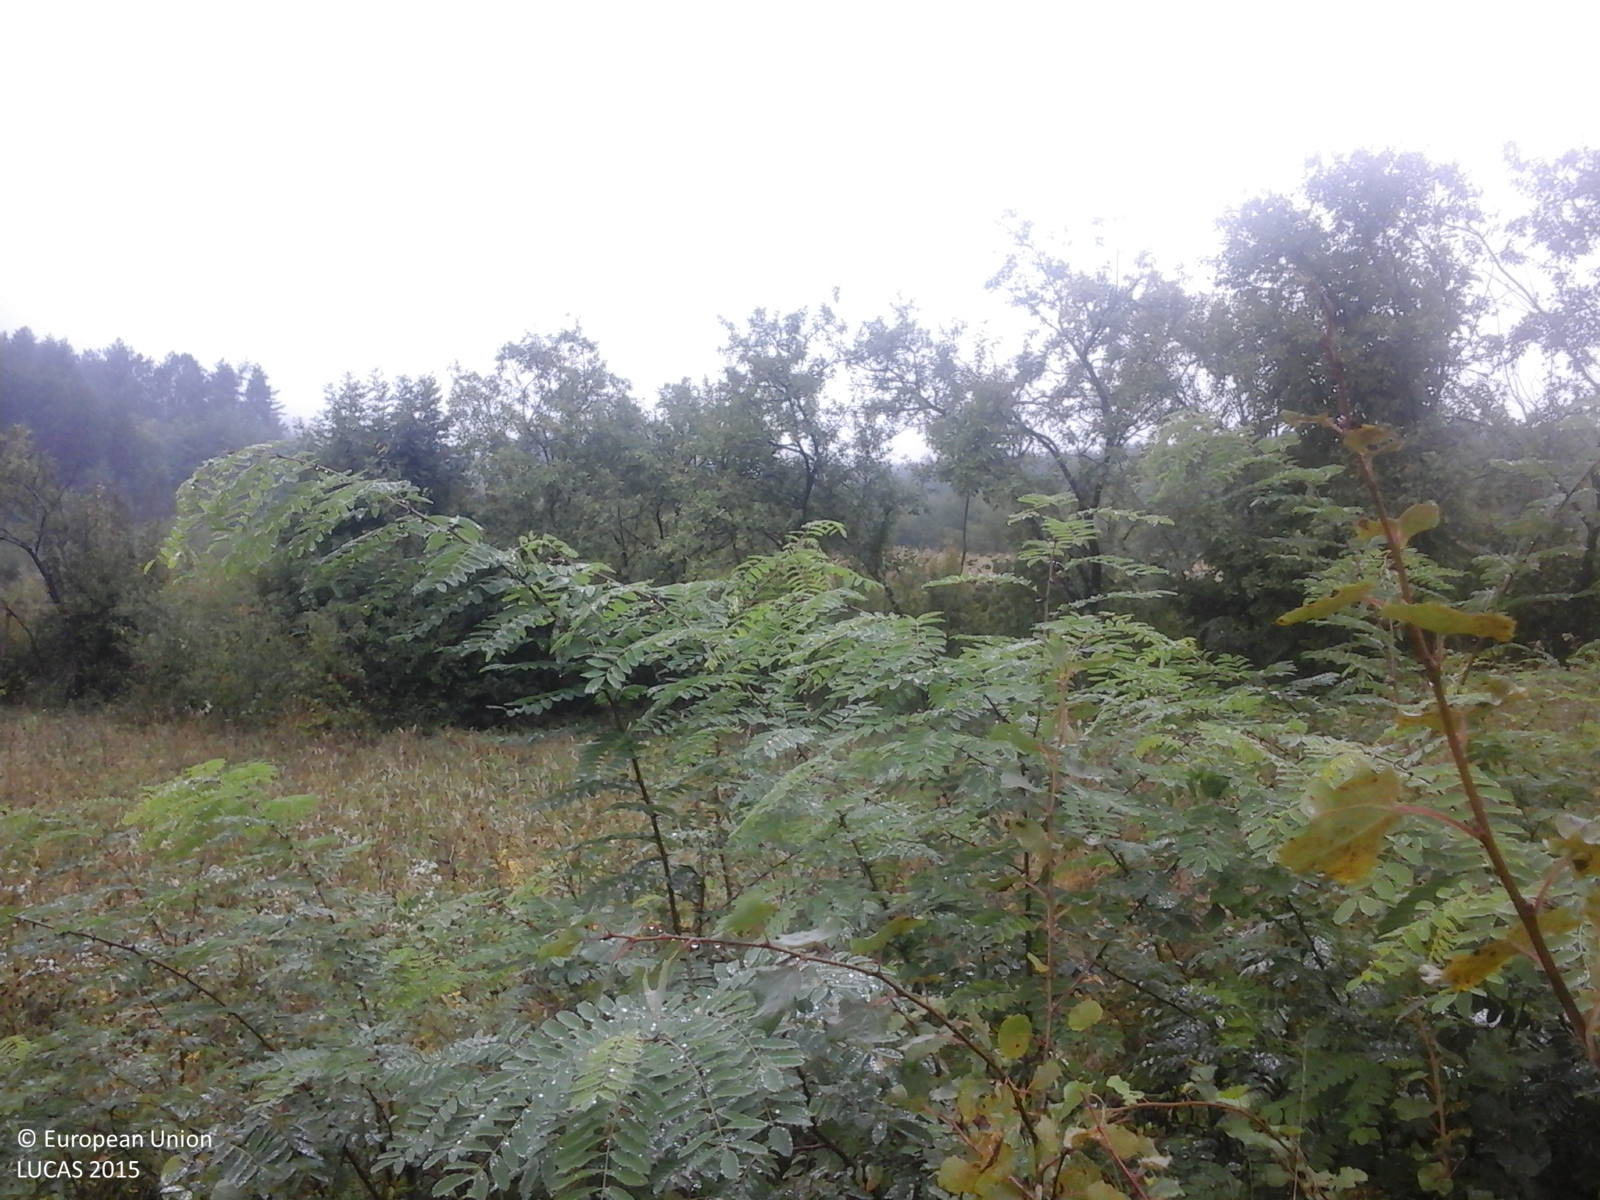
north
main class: Woodland
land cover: Broadleaved woodland
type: mesophytic deciduous forest
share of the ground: > 75 %
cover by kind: broadleaved forest trees 75 %, shrubs 25 %
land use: Semi-natural and natural areas not in use
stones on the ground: < 10 %
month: September
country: RO
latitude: 47.0511
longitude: 22.5209
